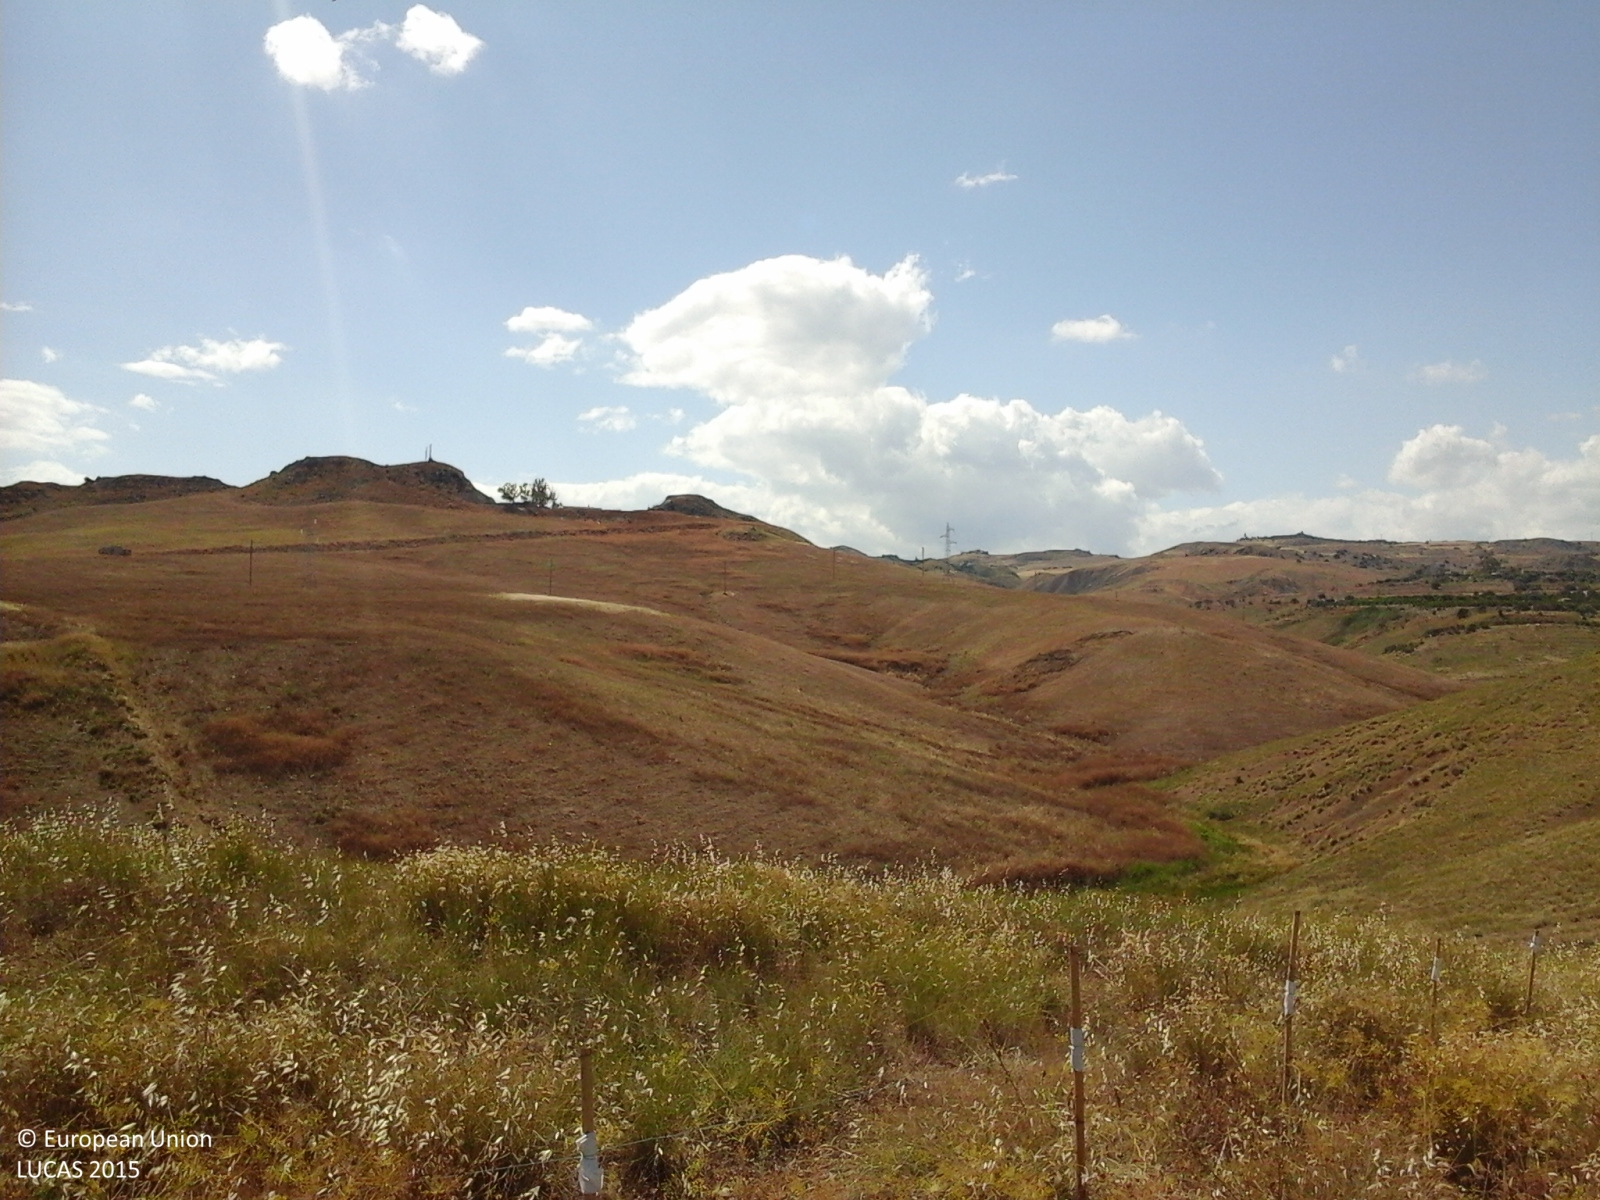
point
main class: Grassland
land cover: Grassland without tree/shrub cover
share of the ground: > 75 %
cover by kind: herbaceous plants 95 %, shrubs 5 %
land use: Agriculture (excluding fallow land and kitchen gardens)
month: June
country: IT
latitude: 37.5513
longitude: 14.8438
